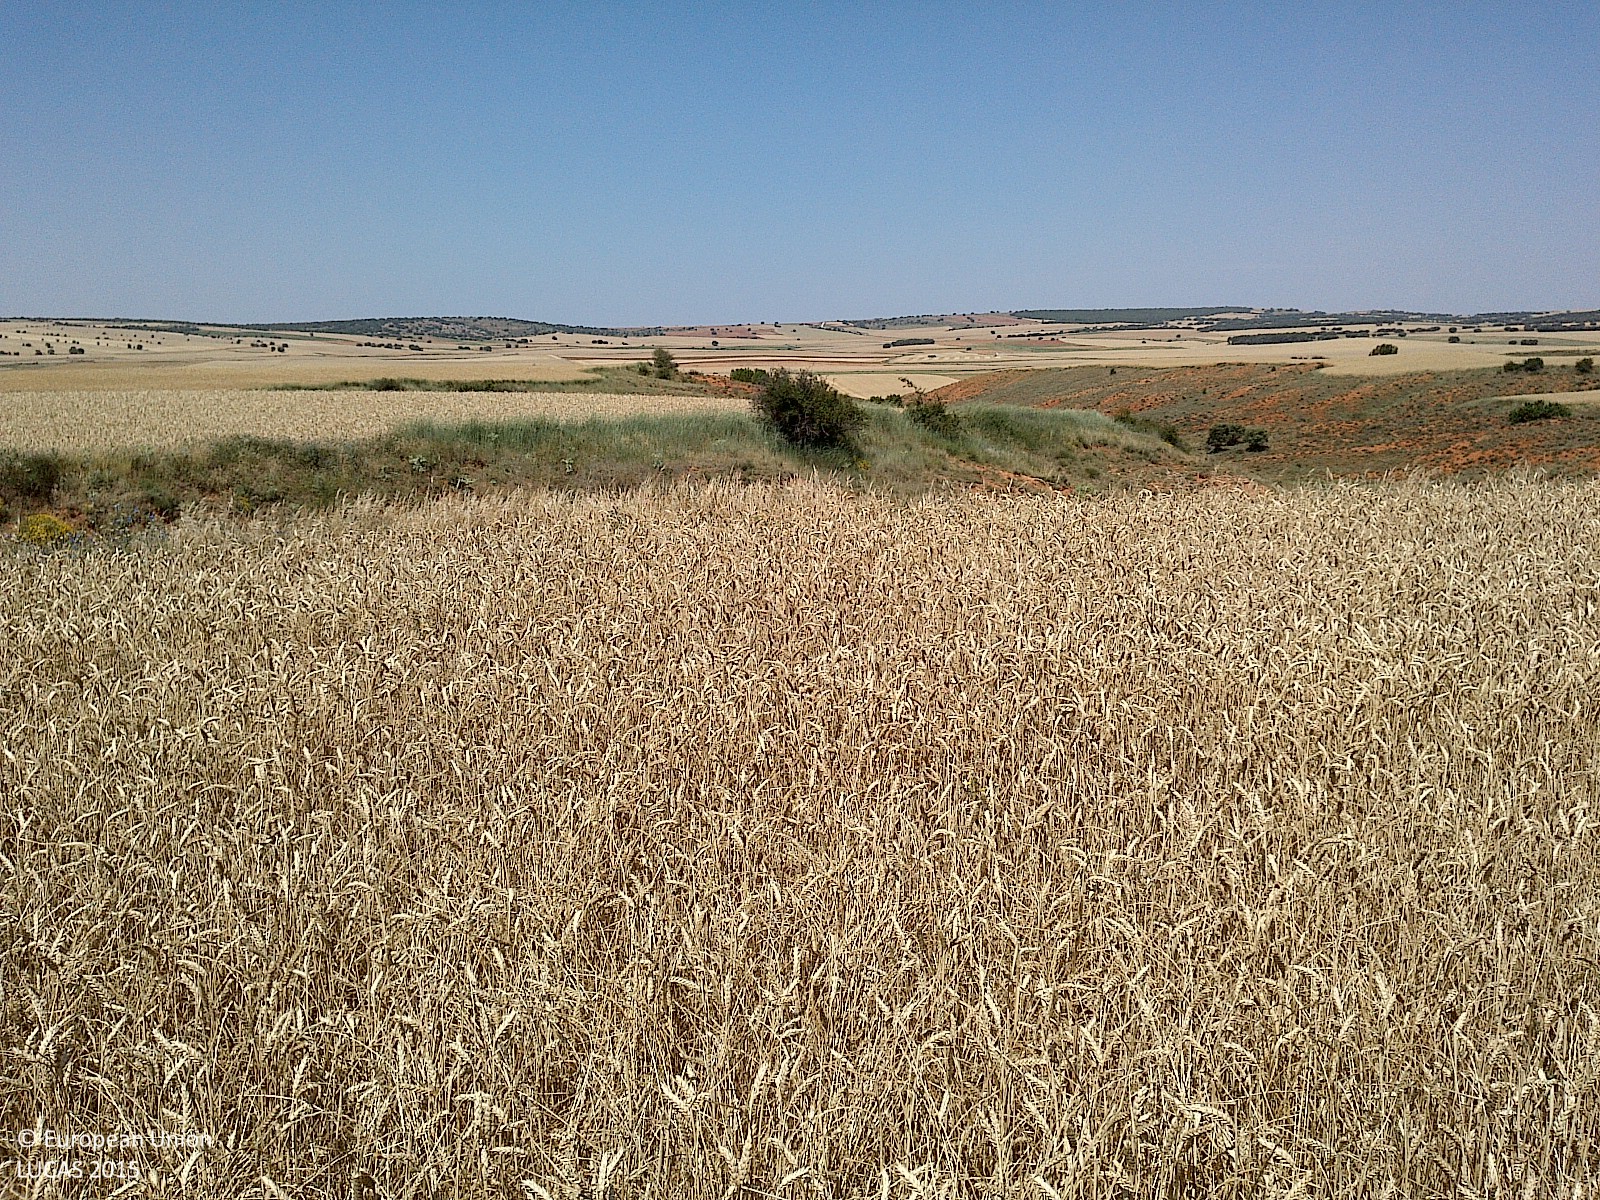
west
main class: Cropland
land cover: Common wheat
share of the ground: > 75 %
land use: Agriculture (excluding fallow land and kitchen gardens)
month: July
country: ES
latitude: 41.5928
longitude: -2.1371
